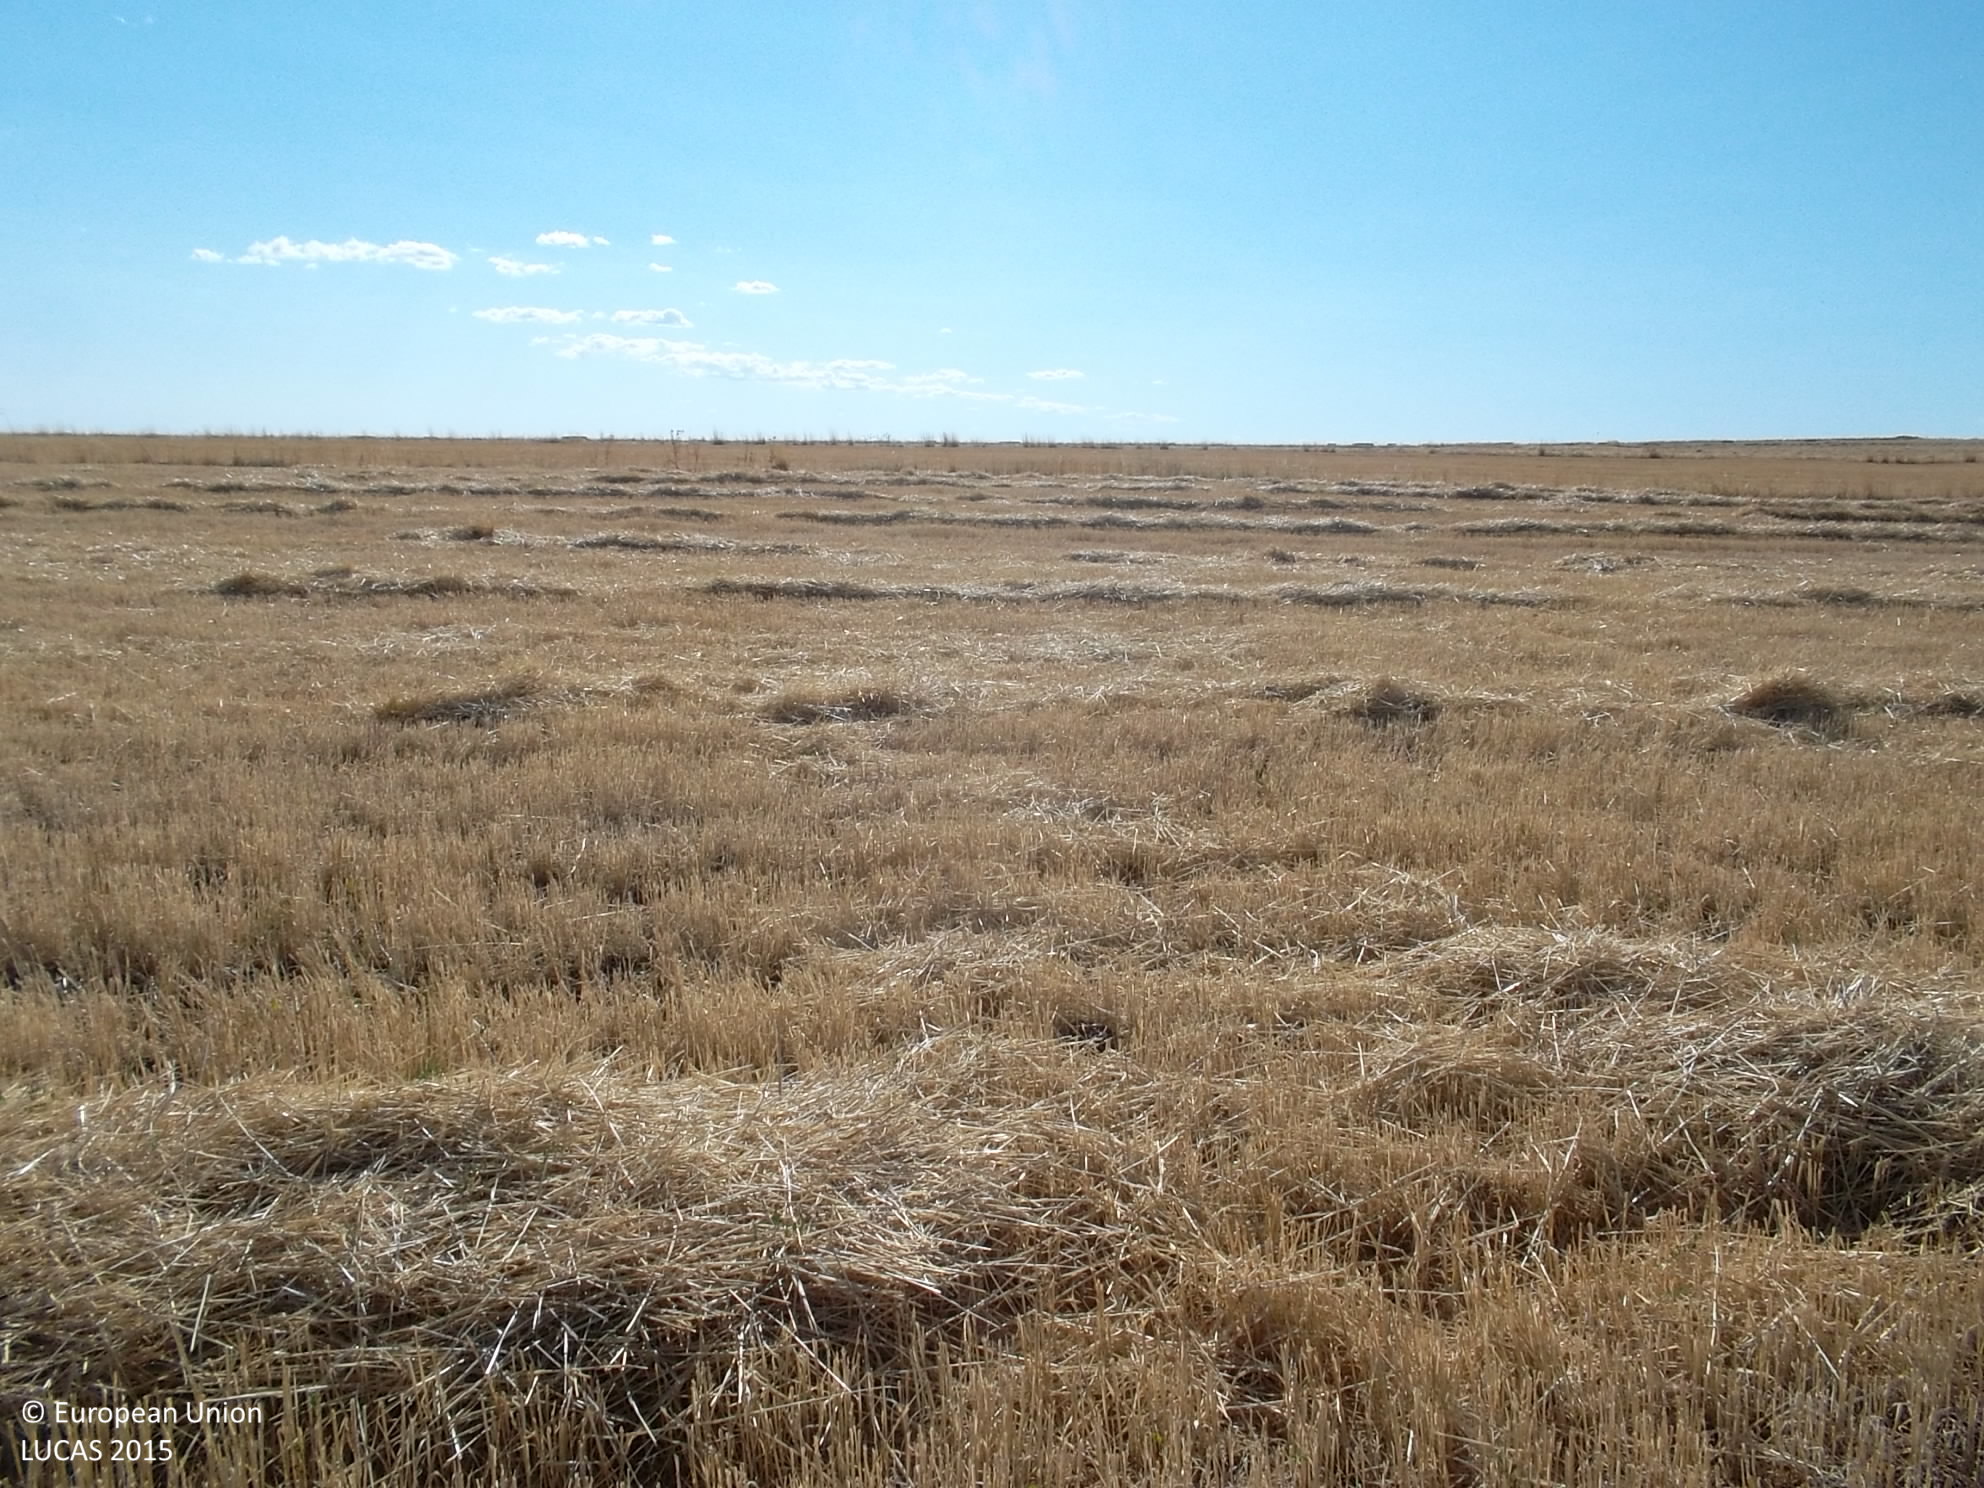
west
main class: Cropland
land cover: Barley
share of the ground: < 10 %
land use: Agriculture (excluding fallow land and kitchen gardens)
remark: Harvested field
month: July
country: ES
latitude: 38.3008
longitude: -5.6663
